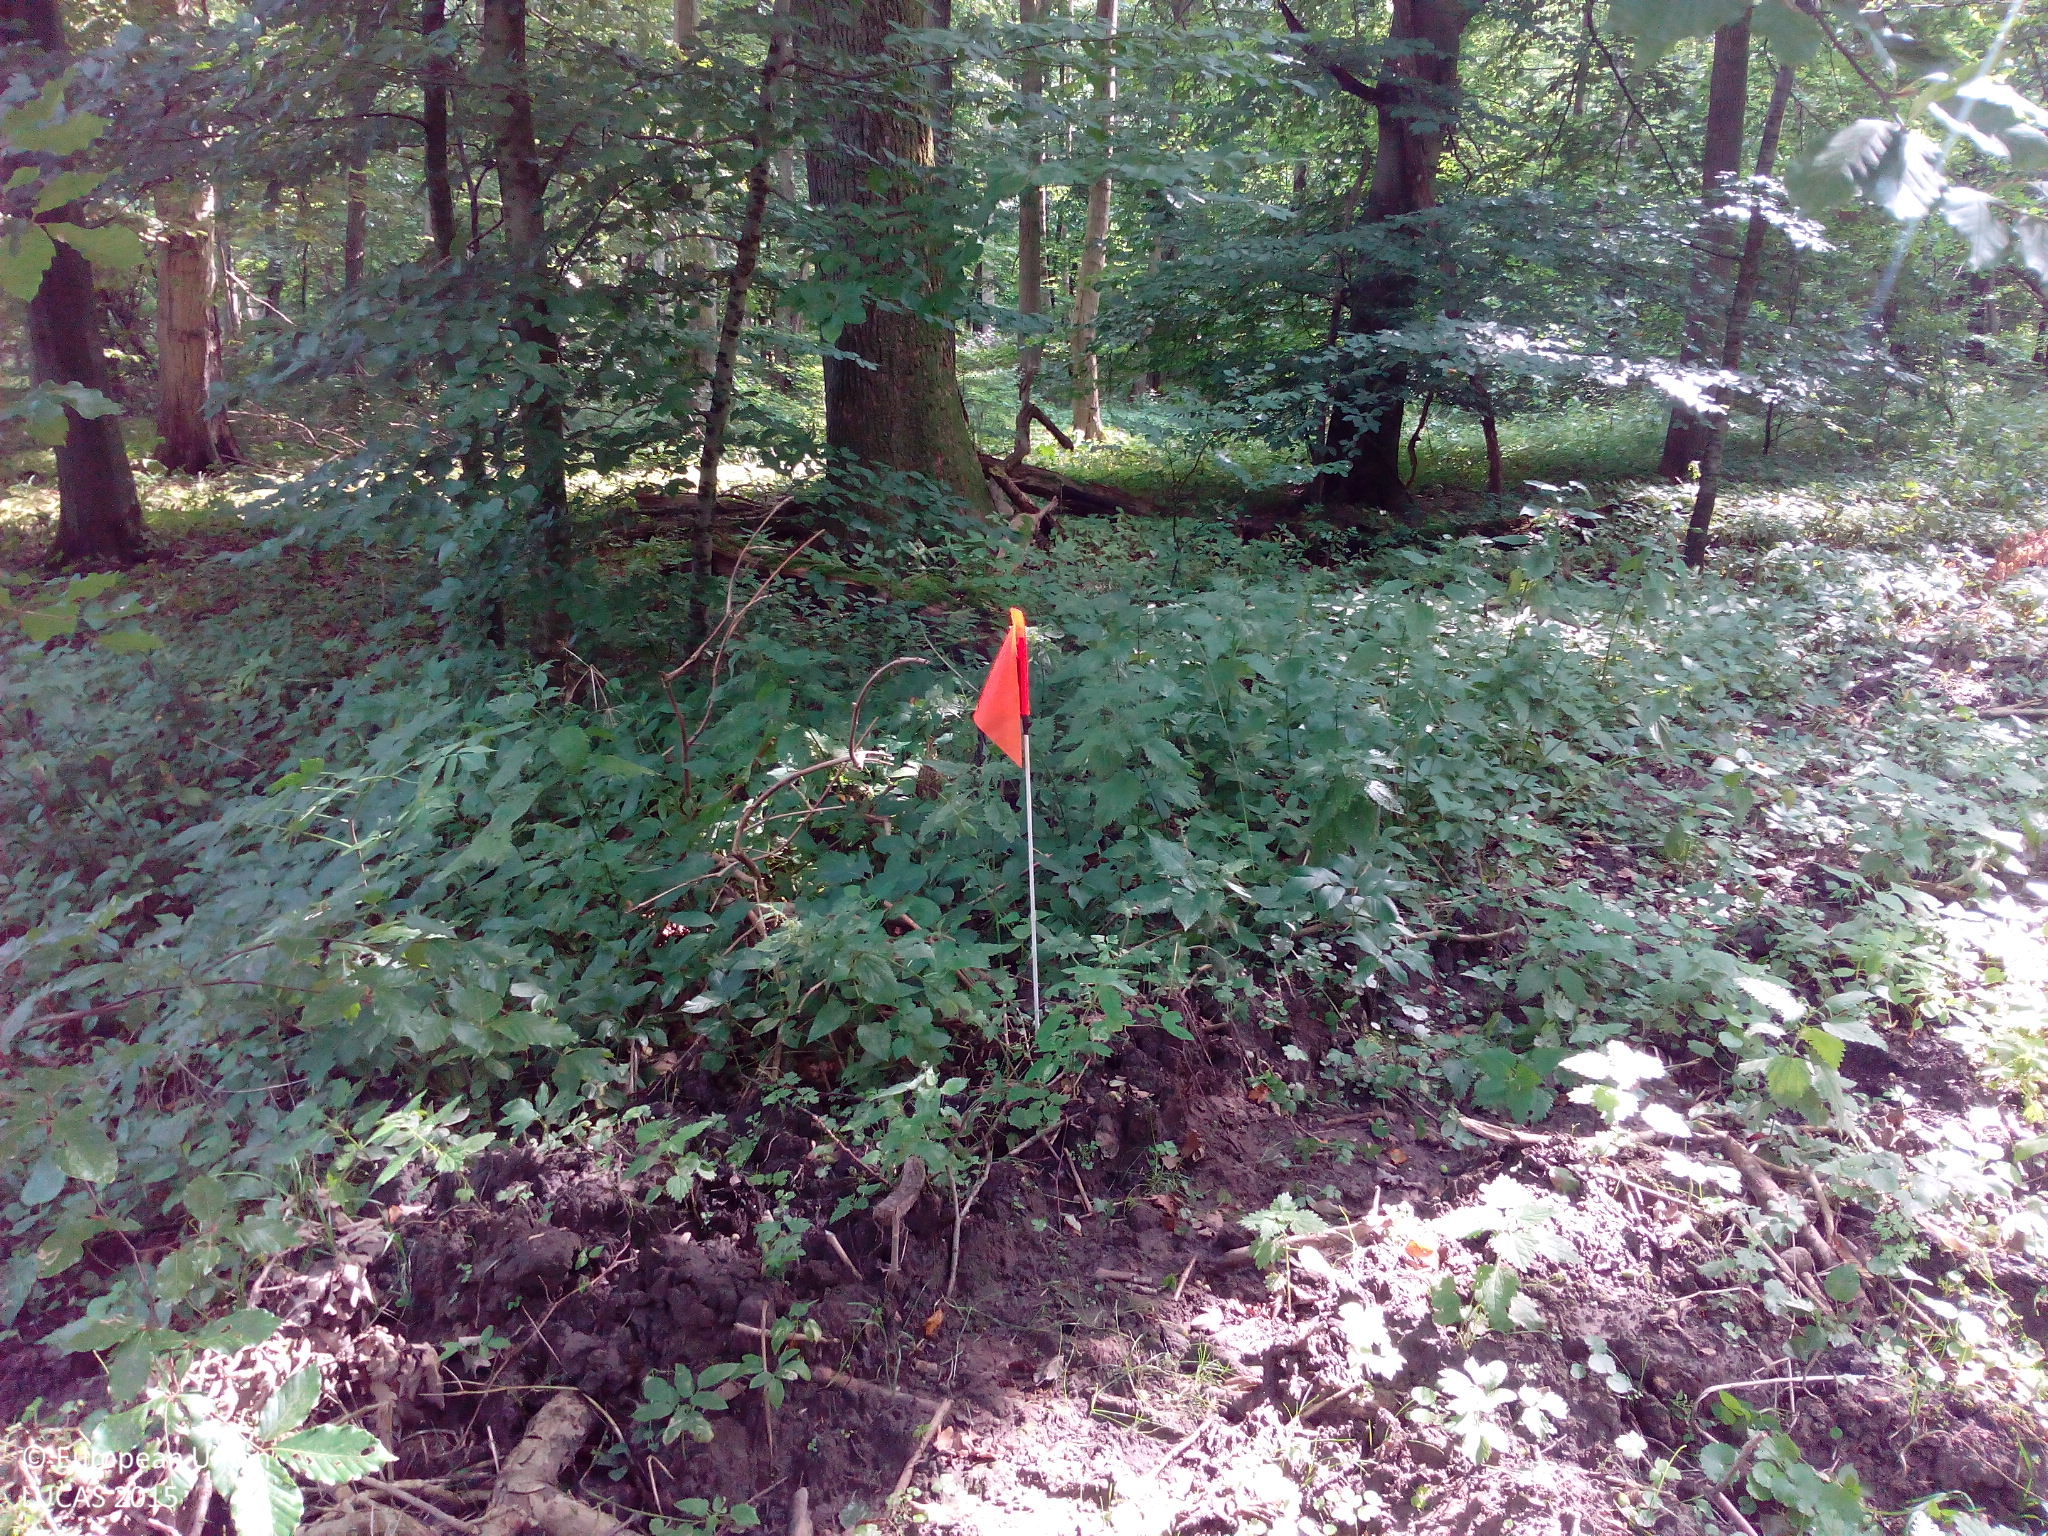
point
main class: Woodland
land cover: Broadleaved woodland
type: mesophytic deciduous forest
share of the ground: > 75 %
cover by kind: broadleaved forest trees 90 %, shrubs 5 %, herbaceous plants 5 %
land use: Forestry
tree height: > 5 m
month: August
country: DE
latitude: 54.2181
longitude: 12.6521
